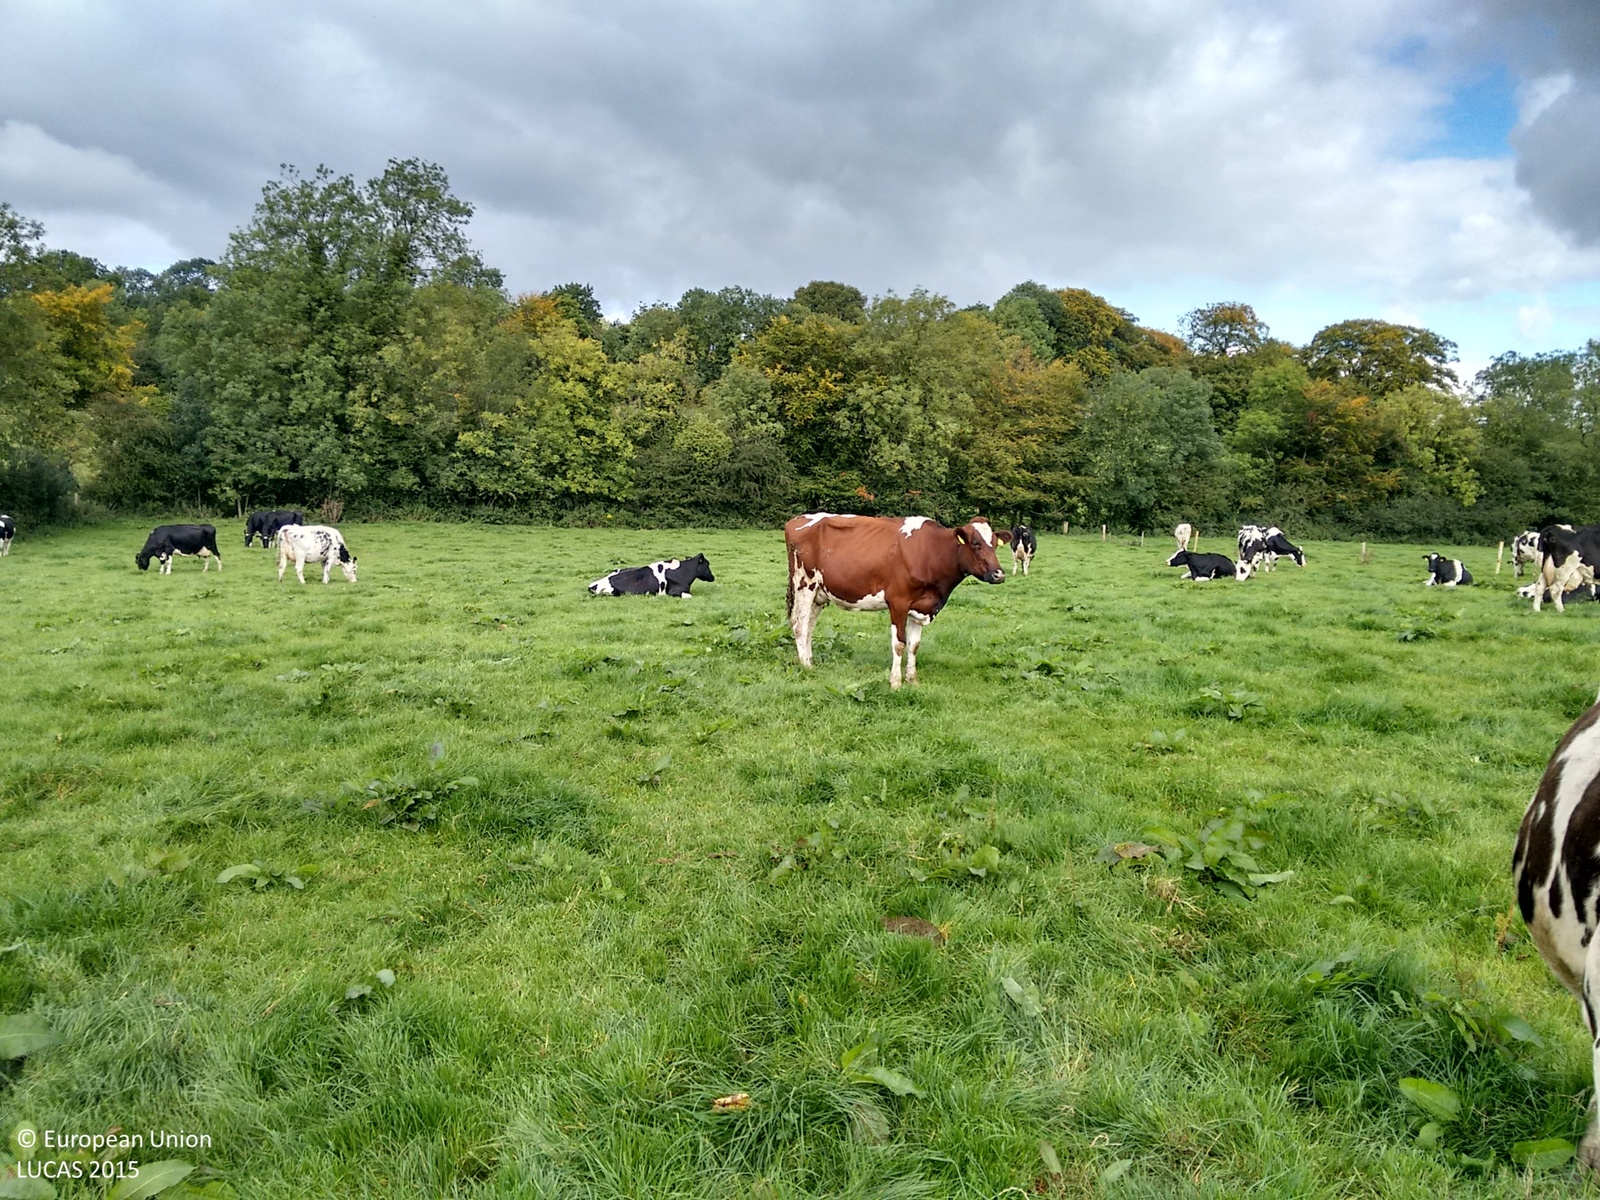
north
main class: Grassland
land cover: Grassland without tree/shrub cover
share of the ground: > 75 %
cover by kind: herbaceous plants 100 %
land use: Agriculture (excluding fallow land and kitchen gardens)
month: September
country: IE
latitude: 54.2906
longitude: -6.9613
